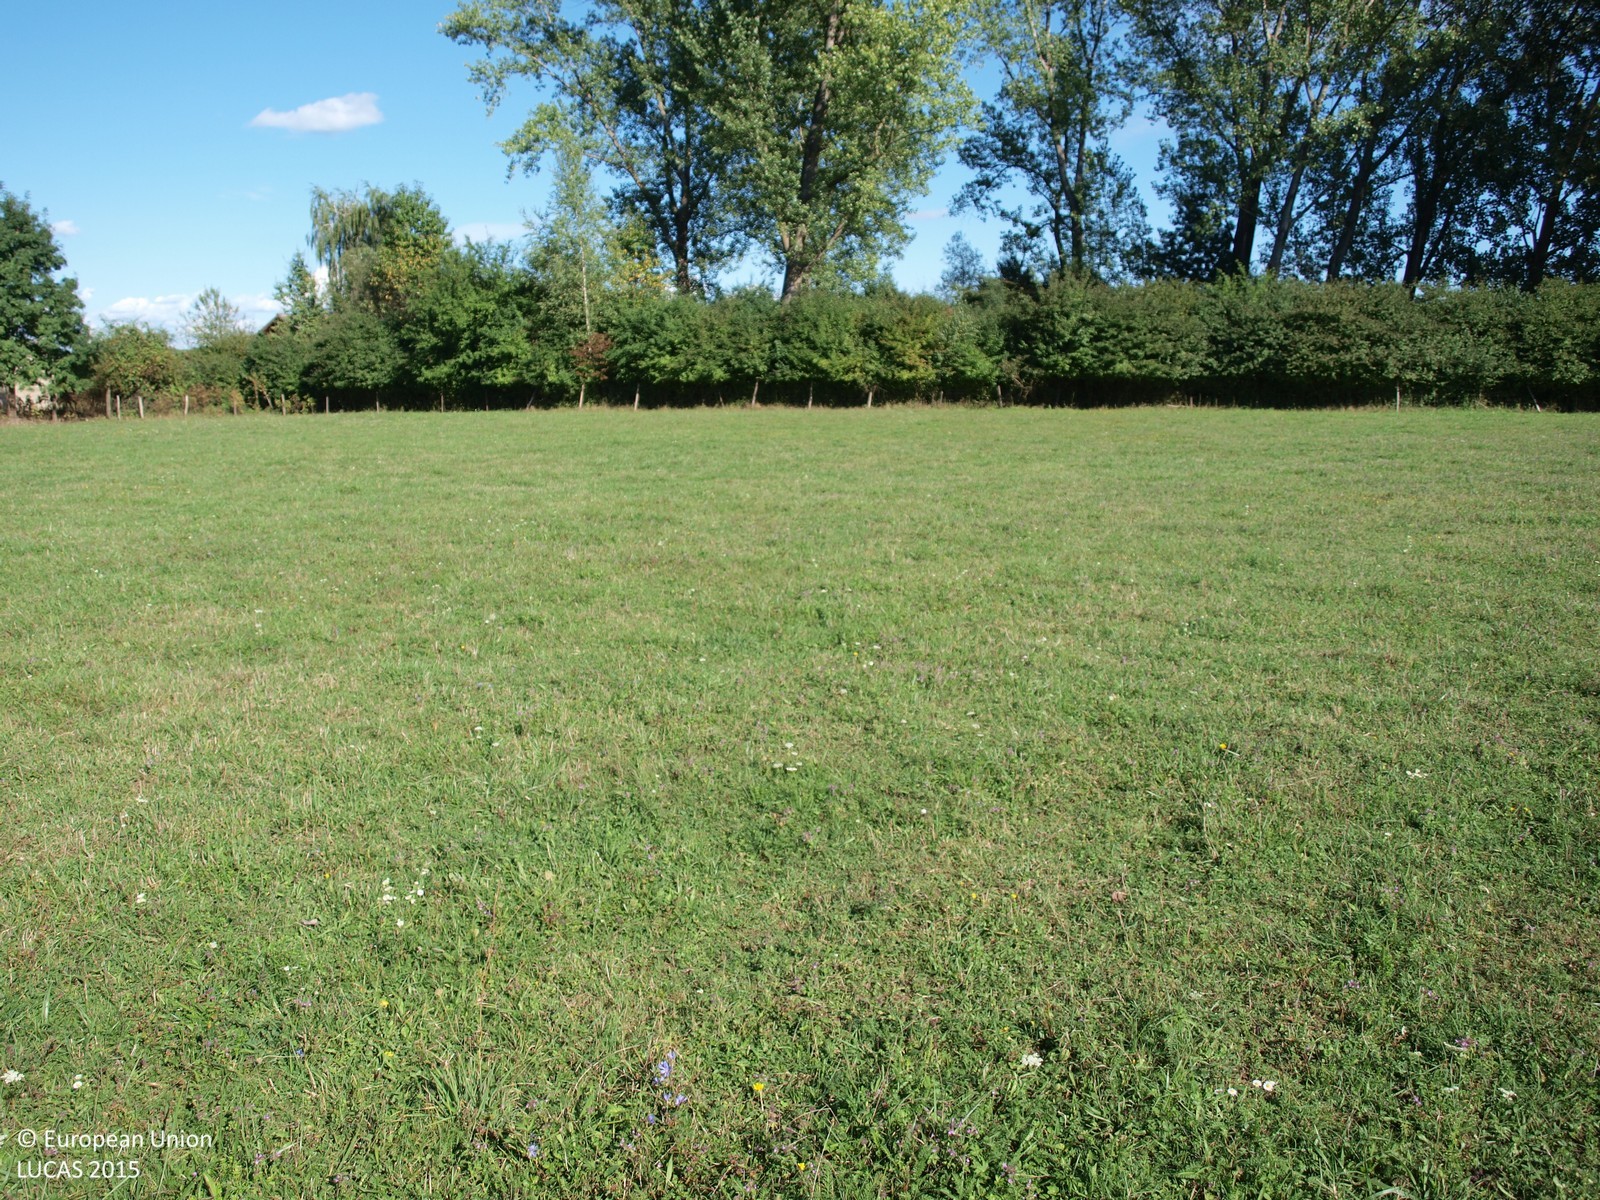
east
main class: Grassland
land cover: Grassland without tree/shrub cover
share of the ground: > 75 %
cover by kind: herbaceous plants 100 %
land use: Agriculture (excluding fallow land and kitchen gardens)
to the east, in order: Grassland without tree/shrub cover; Fences; Abandoned hedges; Tracks; Grass margins; Soya; Maize; Electric lines; Maize
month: September
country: HR
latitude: 45.6565
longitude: 16.3508
